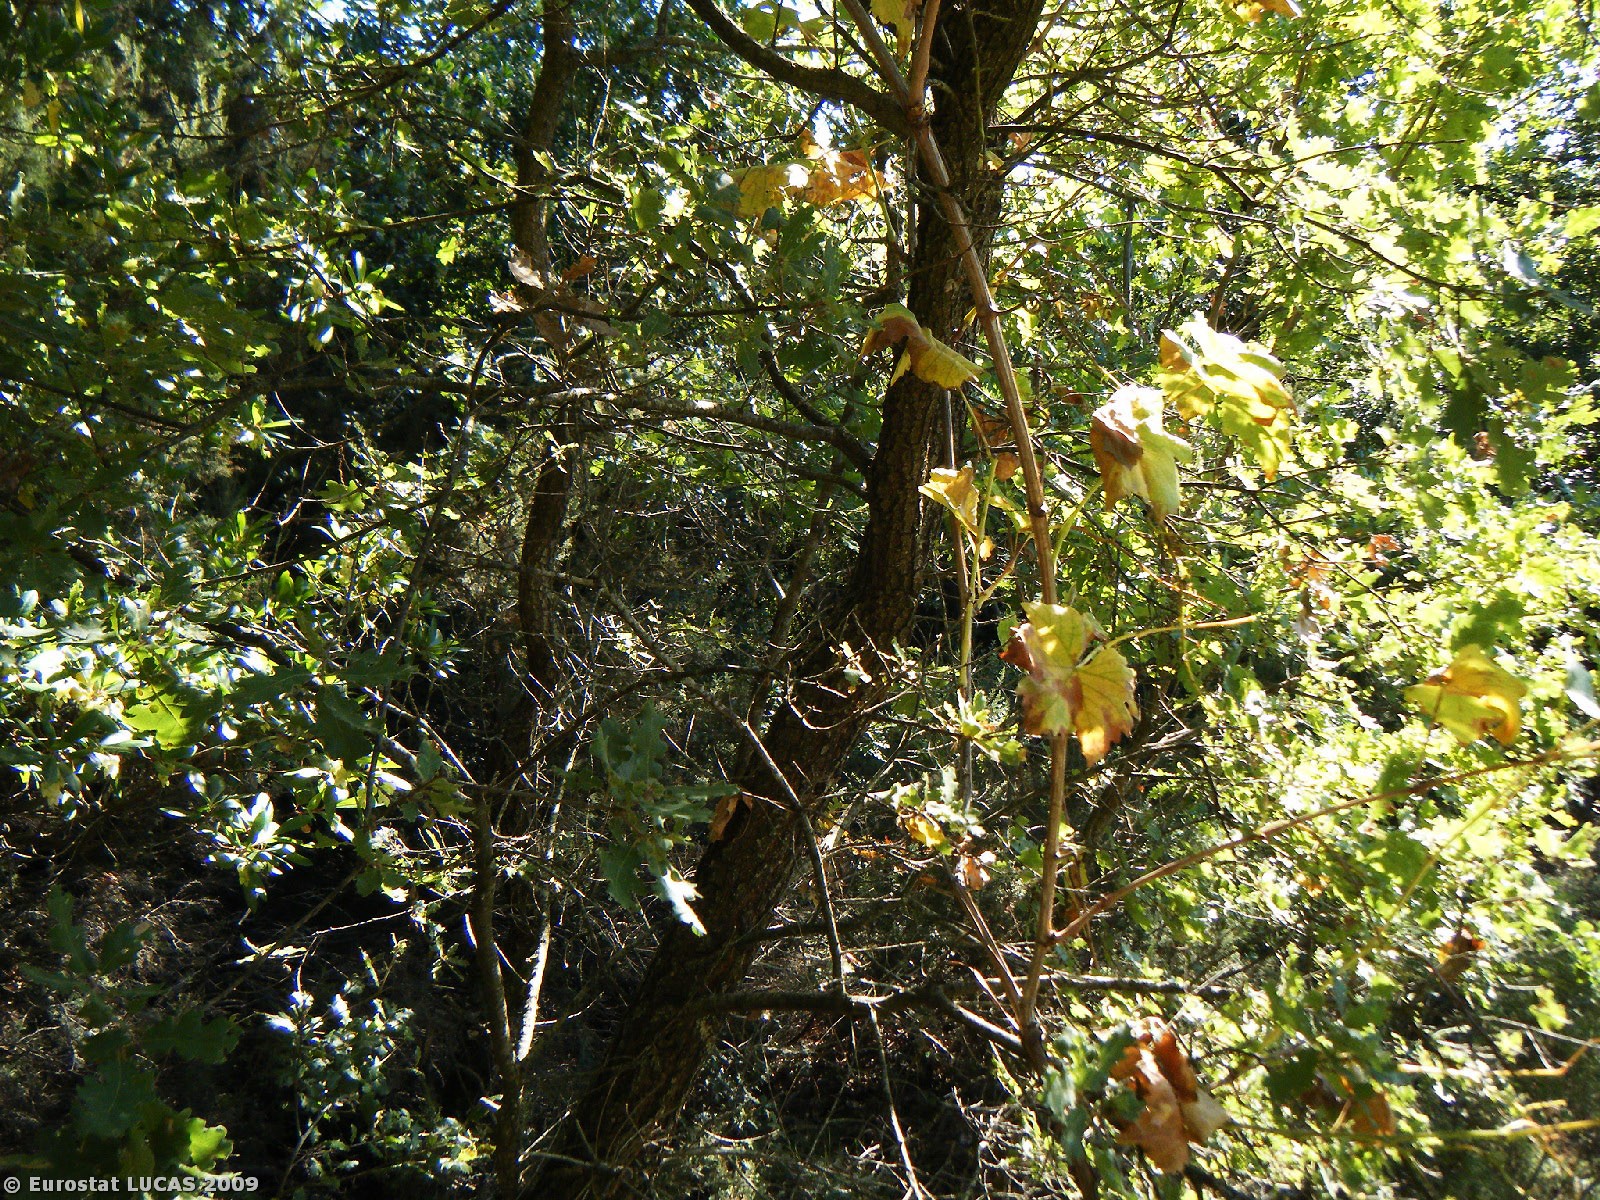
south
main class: Woodland
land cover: Broadleaved woodland
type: thermophilous deciduous forest
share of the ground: > 75 %
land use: Forestry
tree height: > 5 m
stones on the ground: > 50 %
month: October
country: GR
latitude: 37.3047
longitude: 22.3580
